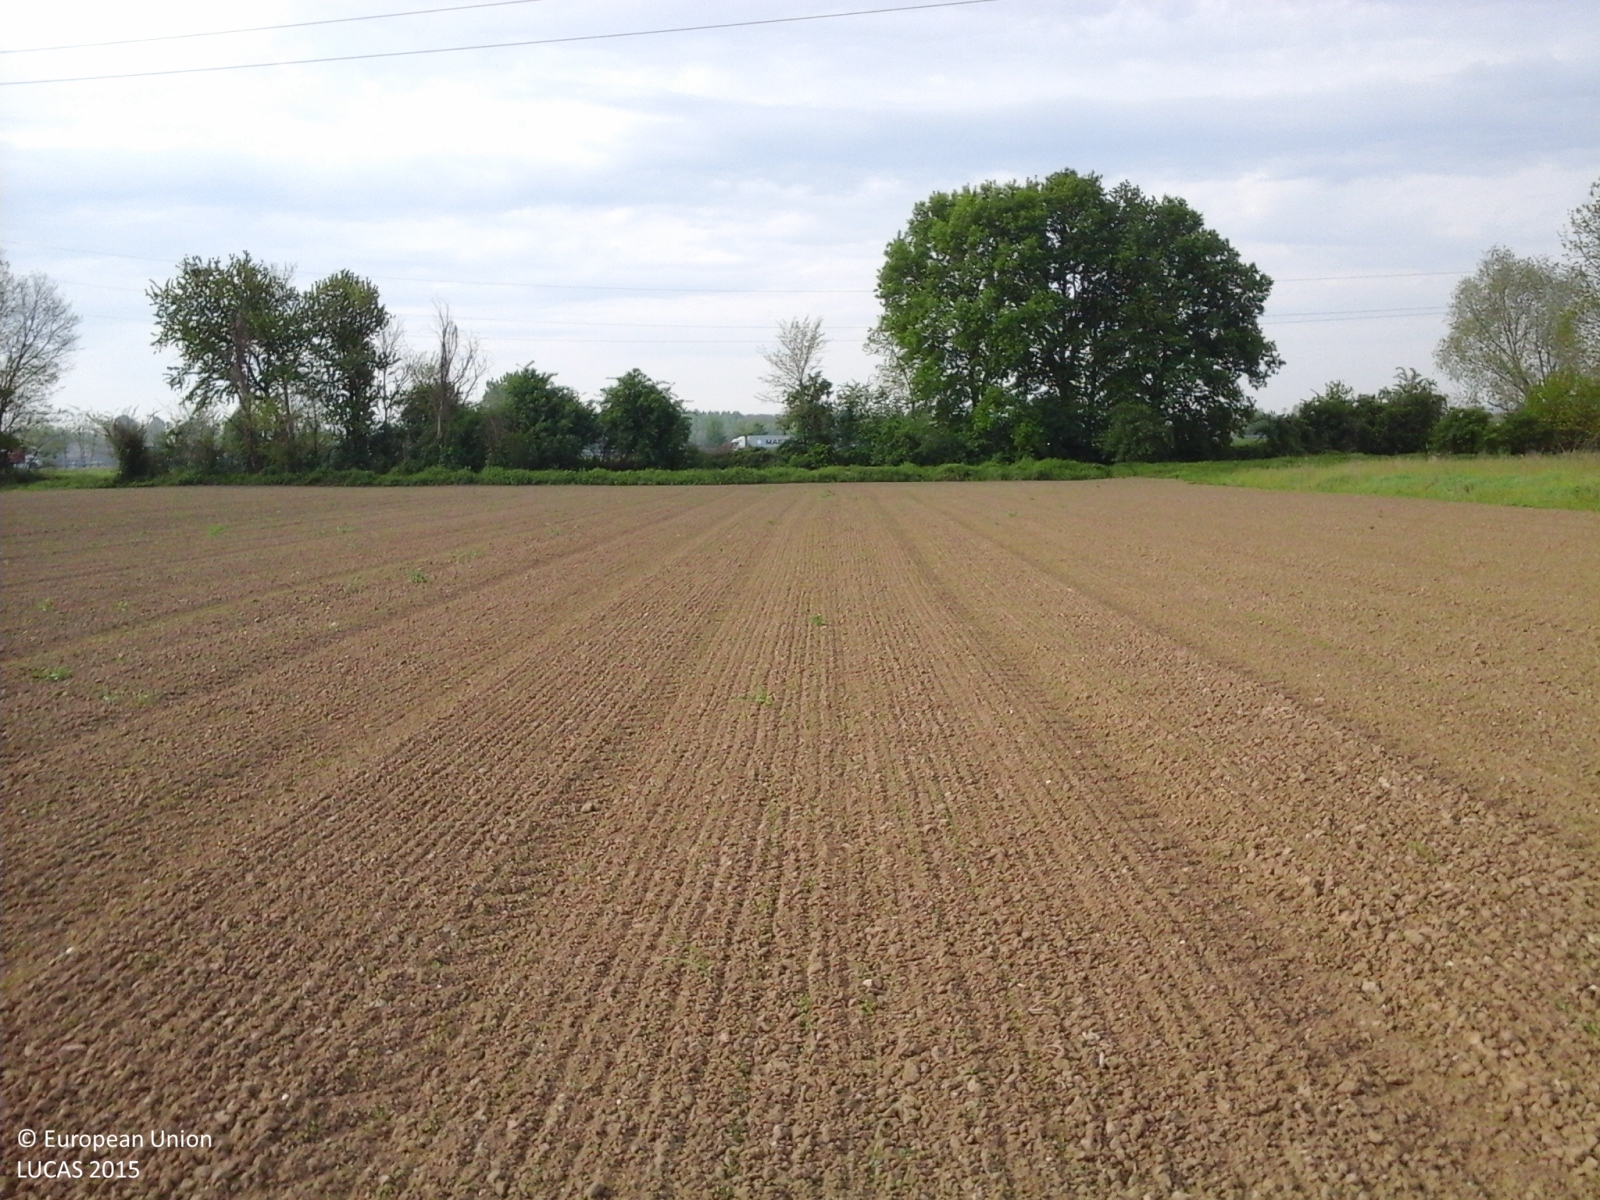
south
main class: Cropland
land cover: Lucerne
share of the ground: < 10 %
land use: Agriculture (excluding fallow land and kitchen gardens)
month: April
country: IT
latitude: 45.0880
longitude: 9.3786
